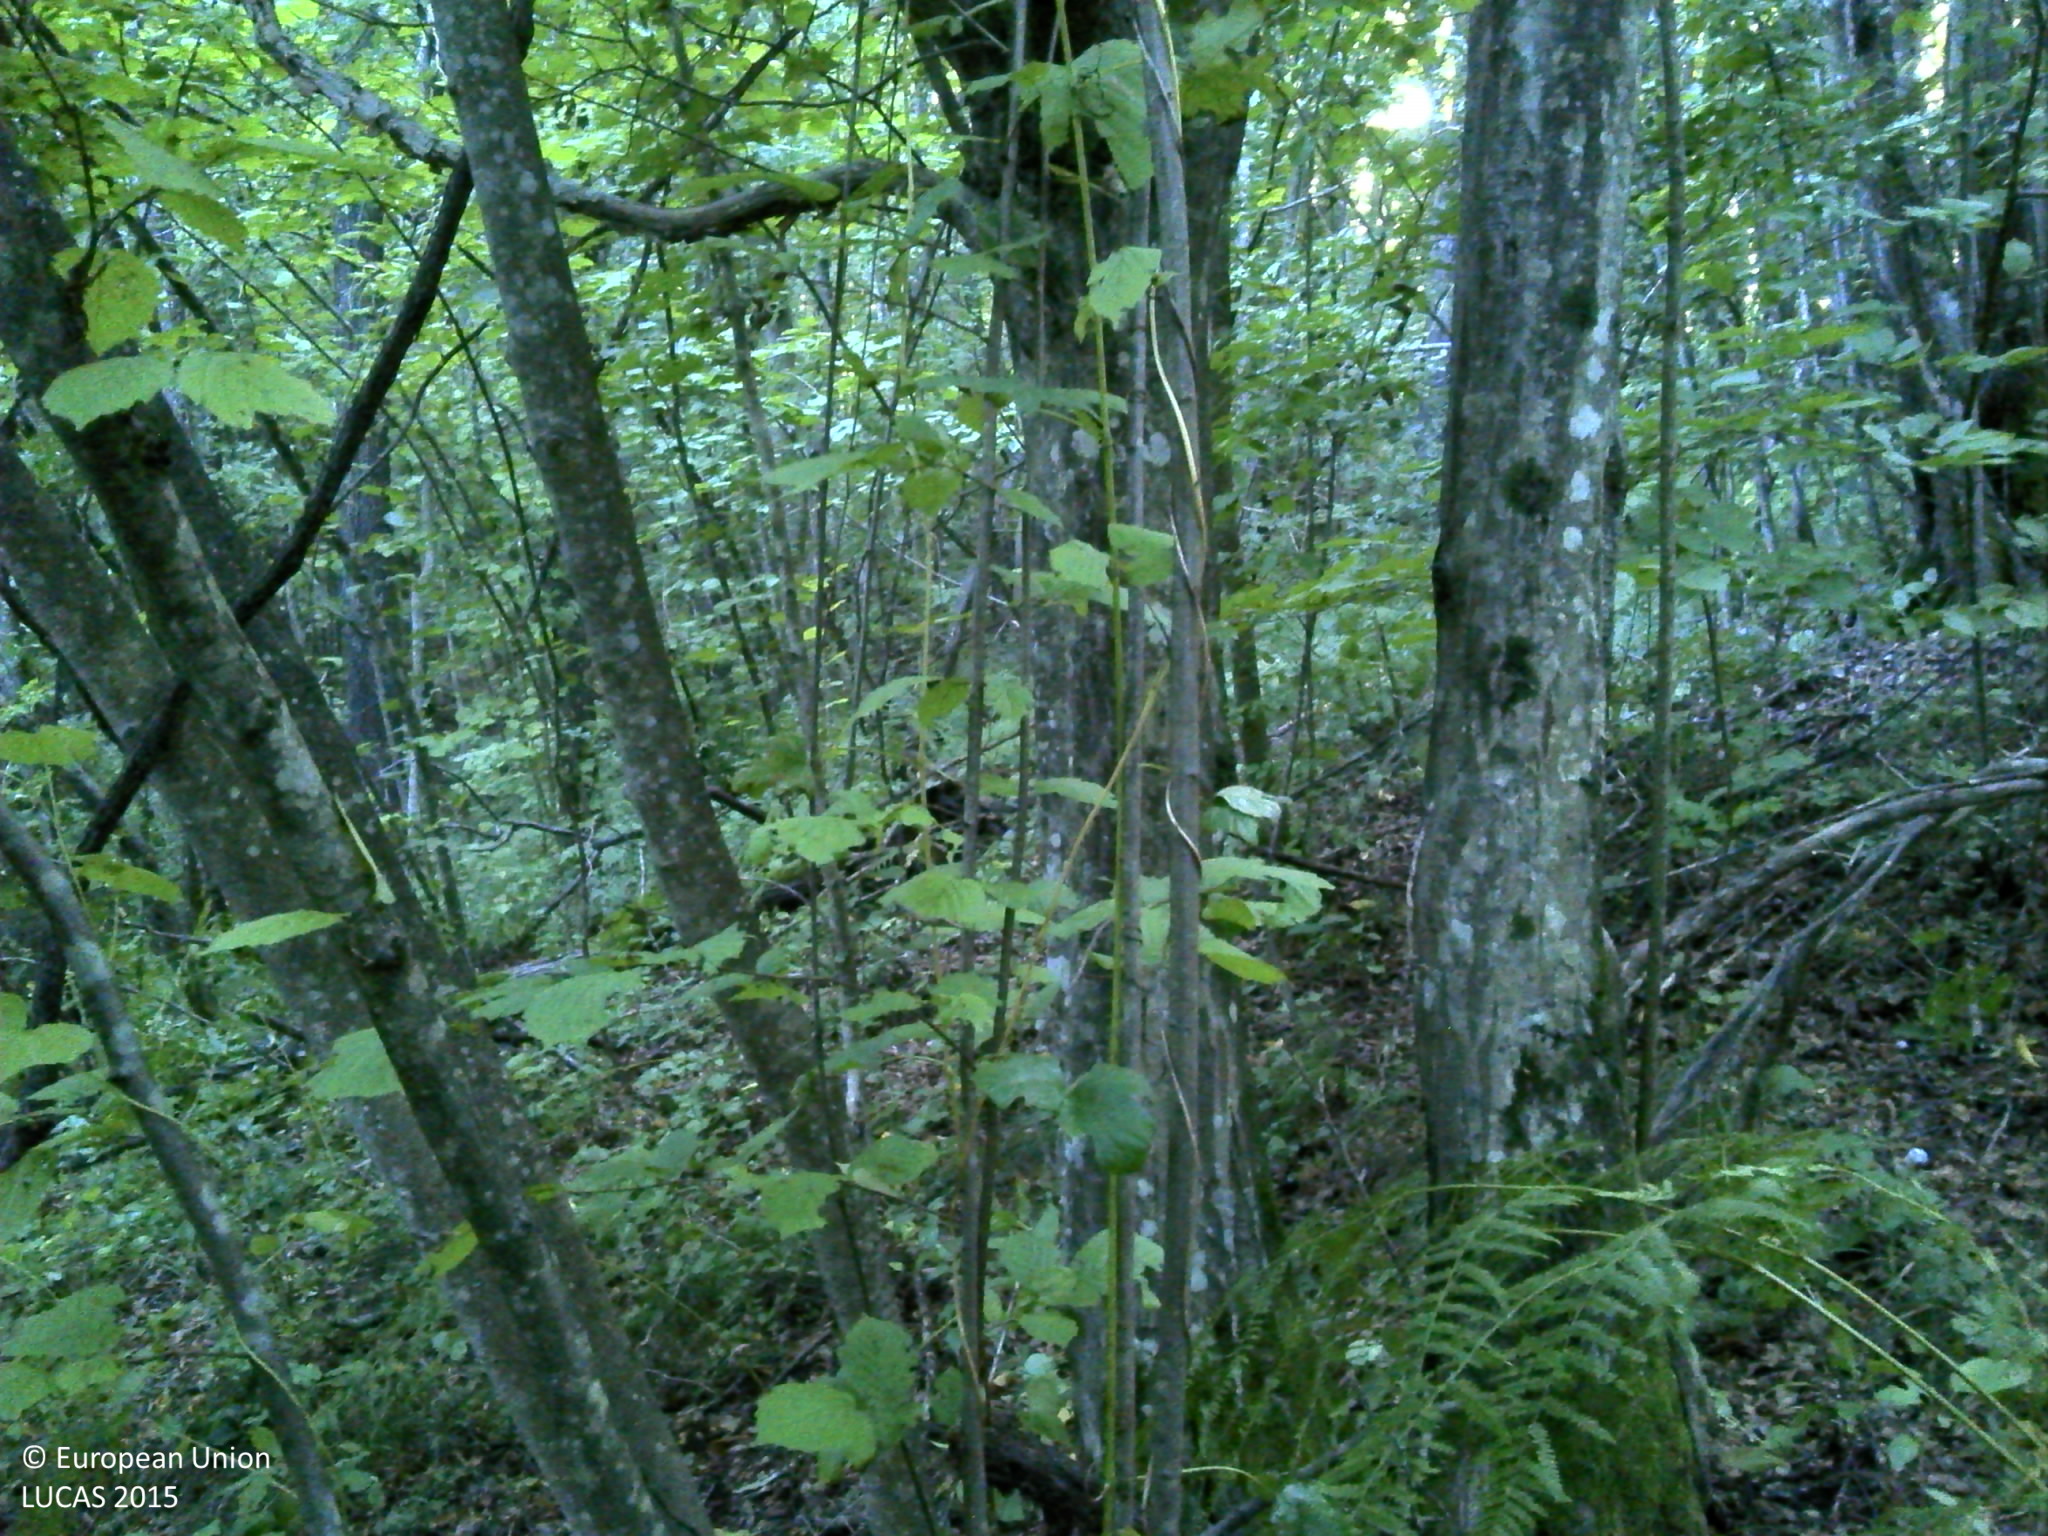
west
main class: Woodland
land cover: Broadleaved woodland
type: beech forest
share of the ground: > 75 %
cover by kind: broadleaved forest trees 100 %
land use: Forestry
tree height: > 5 m
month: August
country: HR
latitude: 45.2852
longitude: 16.5124
